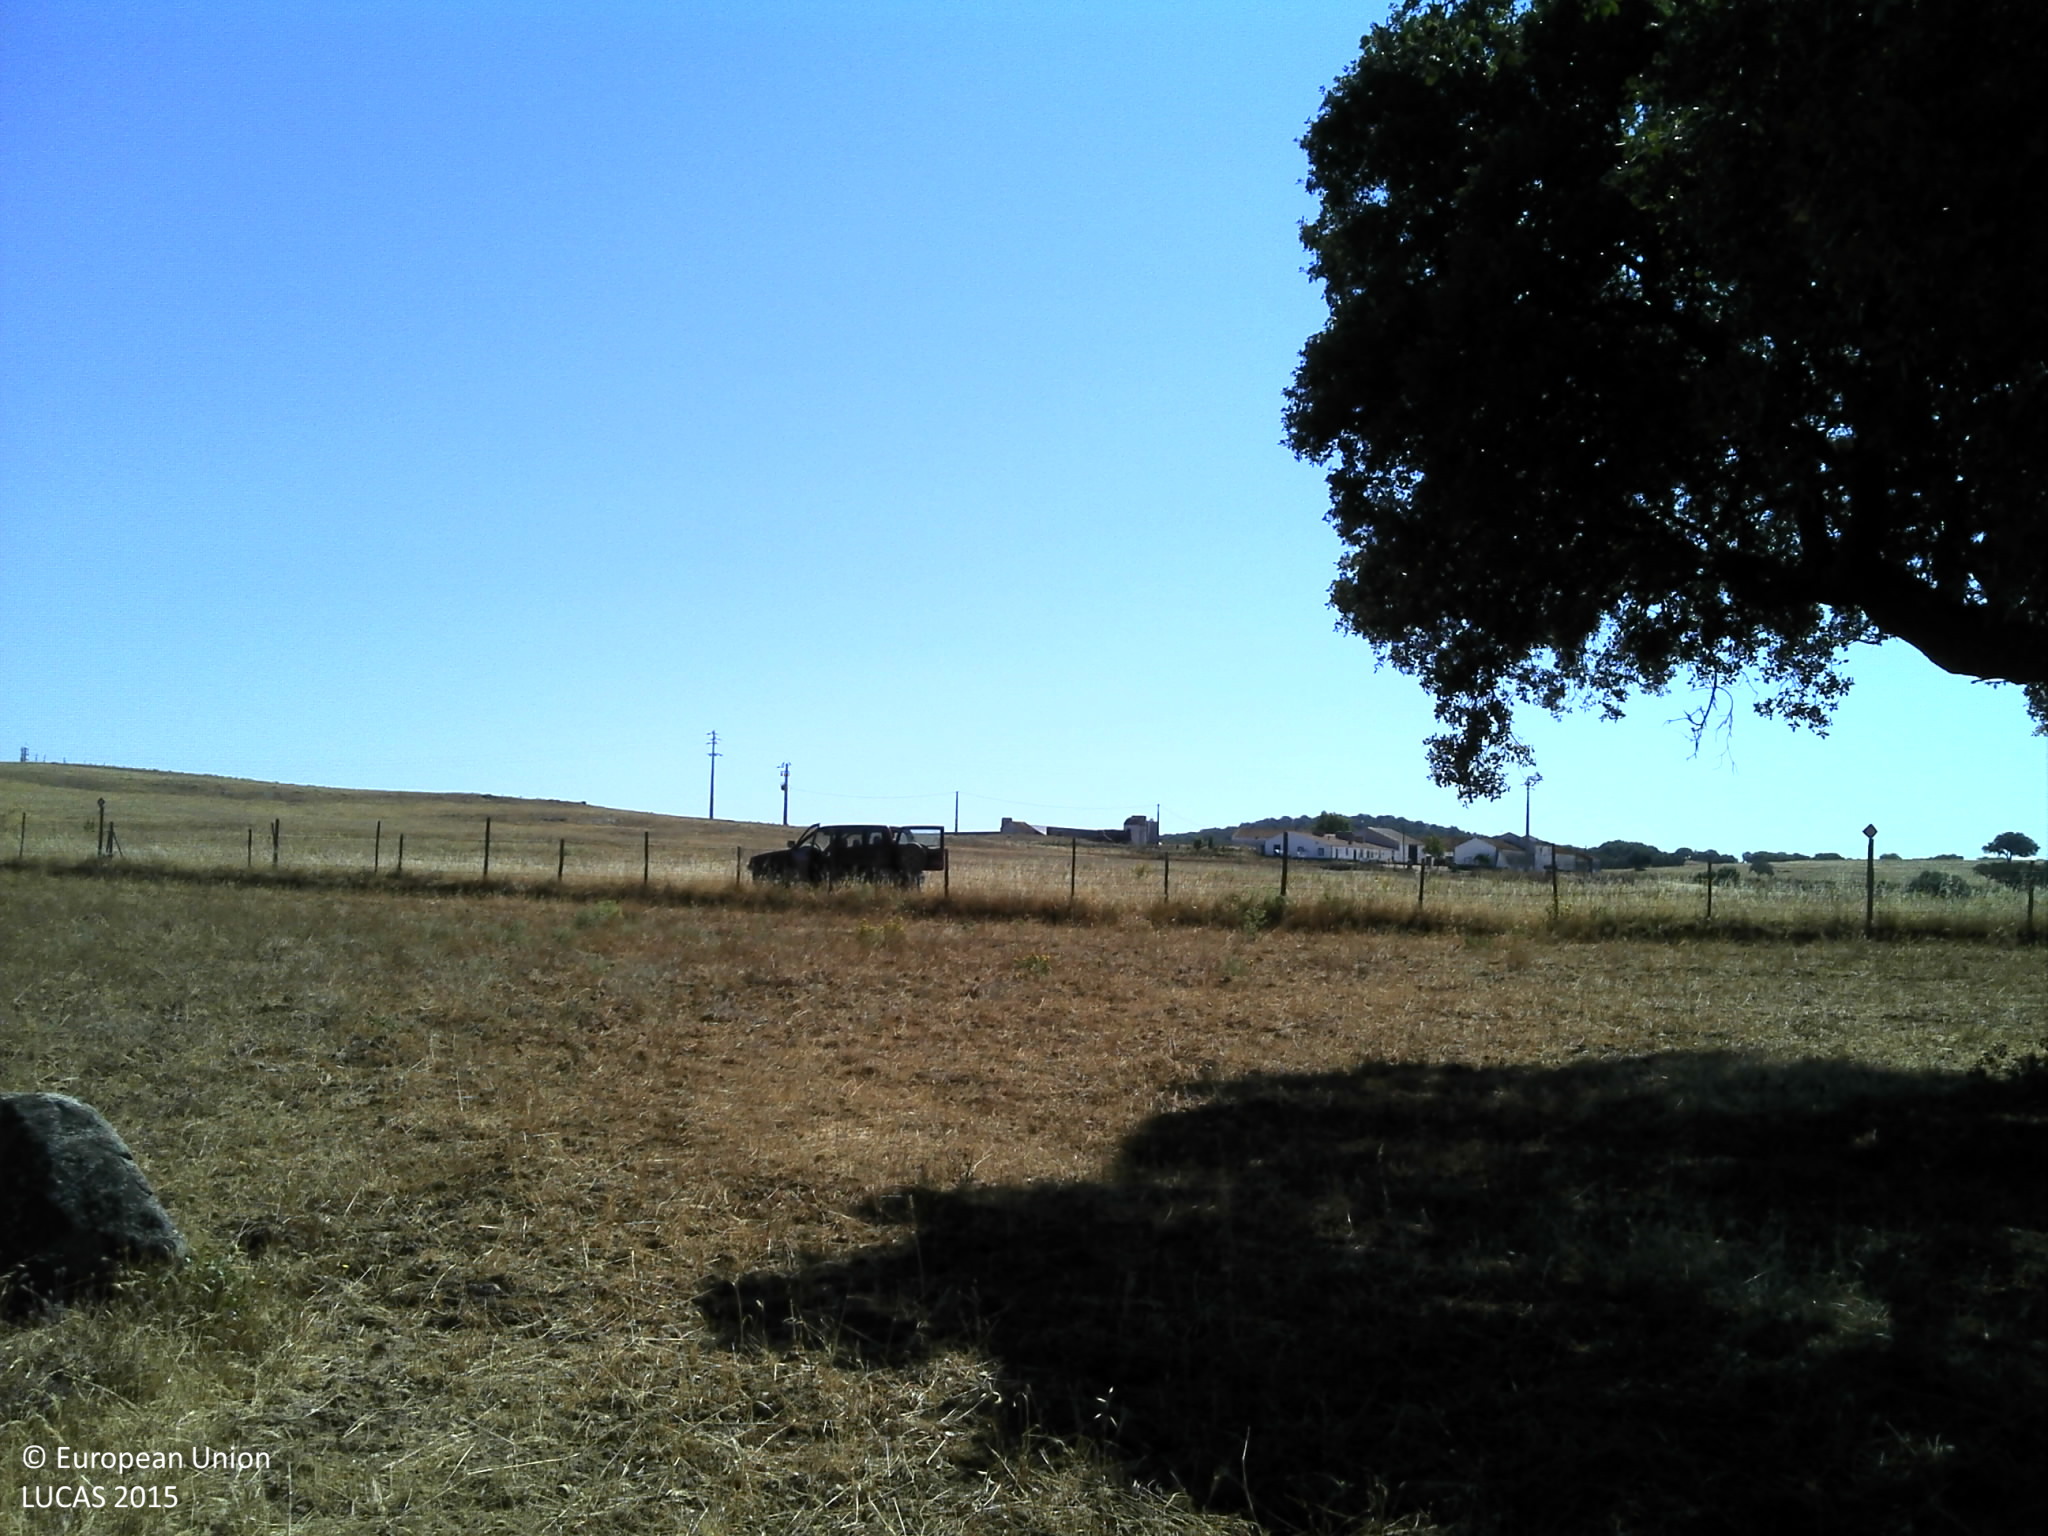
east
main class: Woodland
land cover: Broadleaved woodland
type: broadleaved evergreen forest
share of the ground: 10 - 25 %
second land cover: Grassland without tree/shrub cover
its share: 10 - 25 %
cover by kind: unconsolidated bare surface 70 %, broadleaved forest trees 15 %, herbaceous plants 15 %
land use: Forestry
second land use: Agriculture (excluding fallow land and kitchen gardens)
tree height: > 5 m
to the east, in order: Broadleaved woodland; Grassland without tree/shrub cover; Fences; Grassland without tree/shrub cover; Fences; Electric lines; Tracks; Grassland without tree/shrub cover
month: June
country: PT
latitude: 38.4544
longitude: -8.1134
